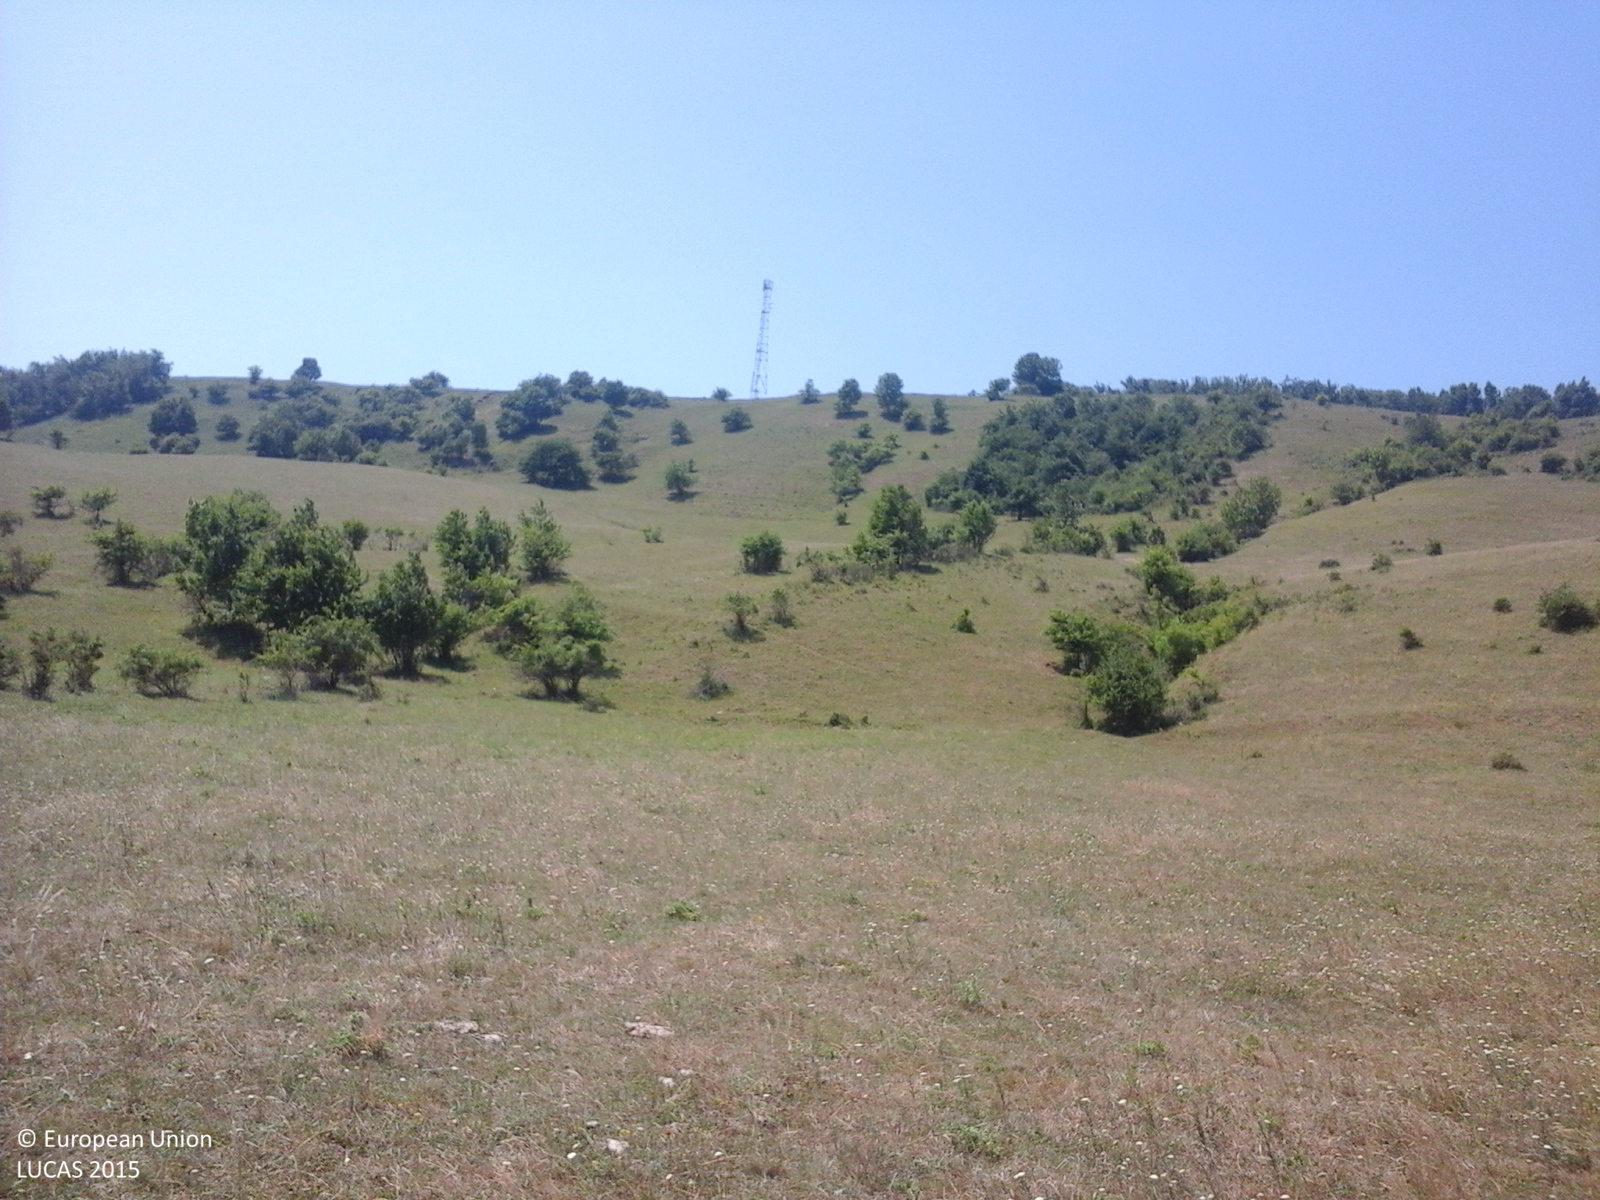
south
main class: Grassland
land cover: Grassland without tree/shrub cover
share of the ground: > 75 %
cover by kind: herbaceous plants 100 %
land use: Agriculture (excluding fallow land and kitchen gardens)
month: June
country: RO
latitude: 46.8749
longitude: 27.8777
